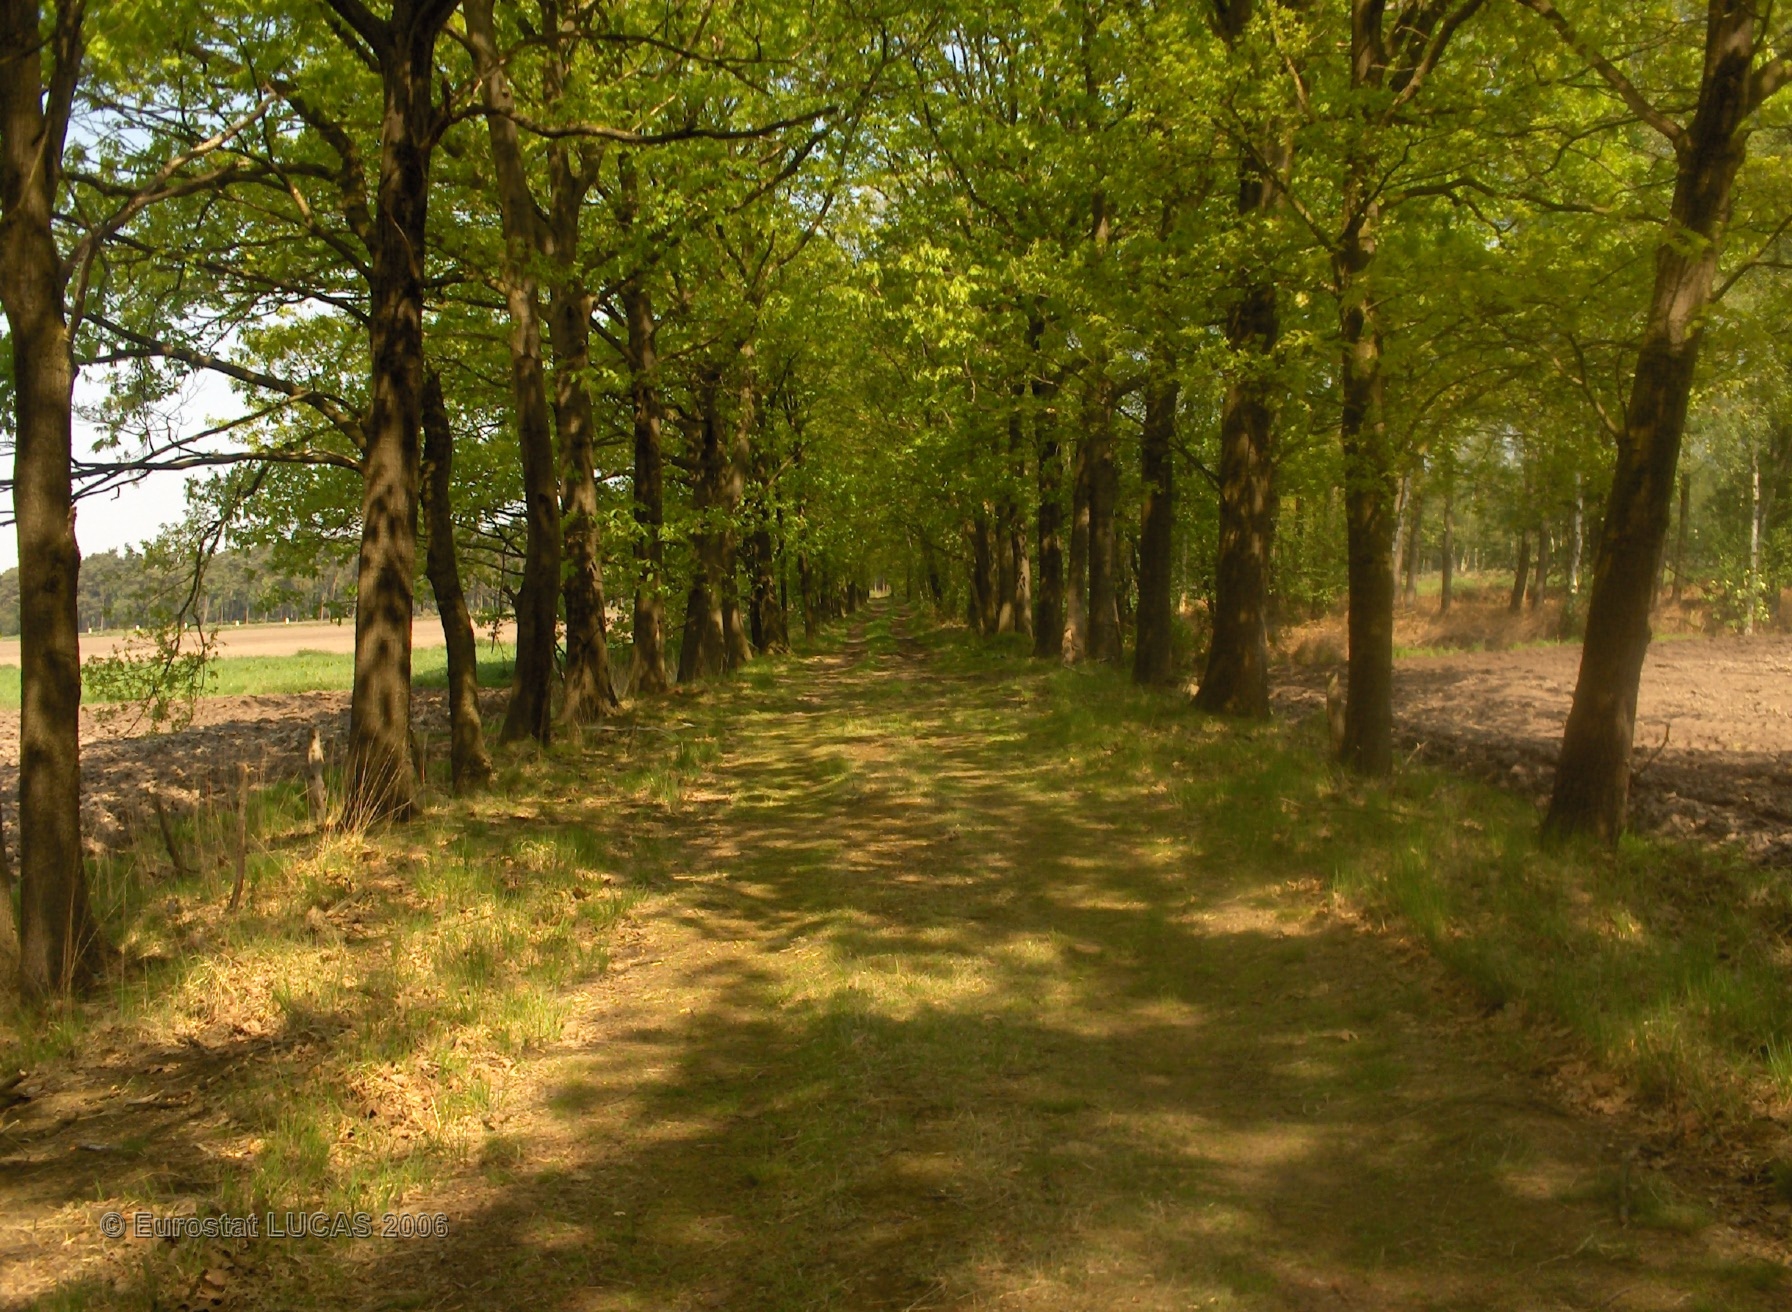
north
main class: Artificial land
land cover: Non built-up linear features
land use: Road transport
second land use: Agriculture (excluding fallow land and kitchen gardens)
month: May
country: BE
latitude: 51.2706
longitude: 5.1671
